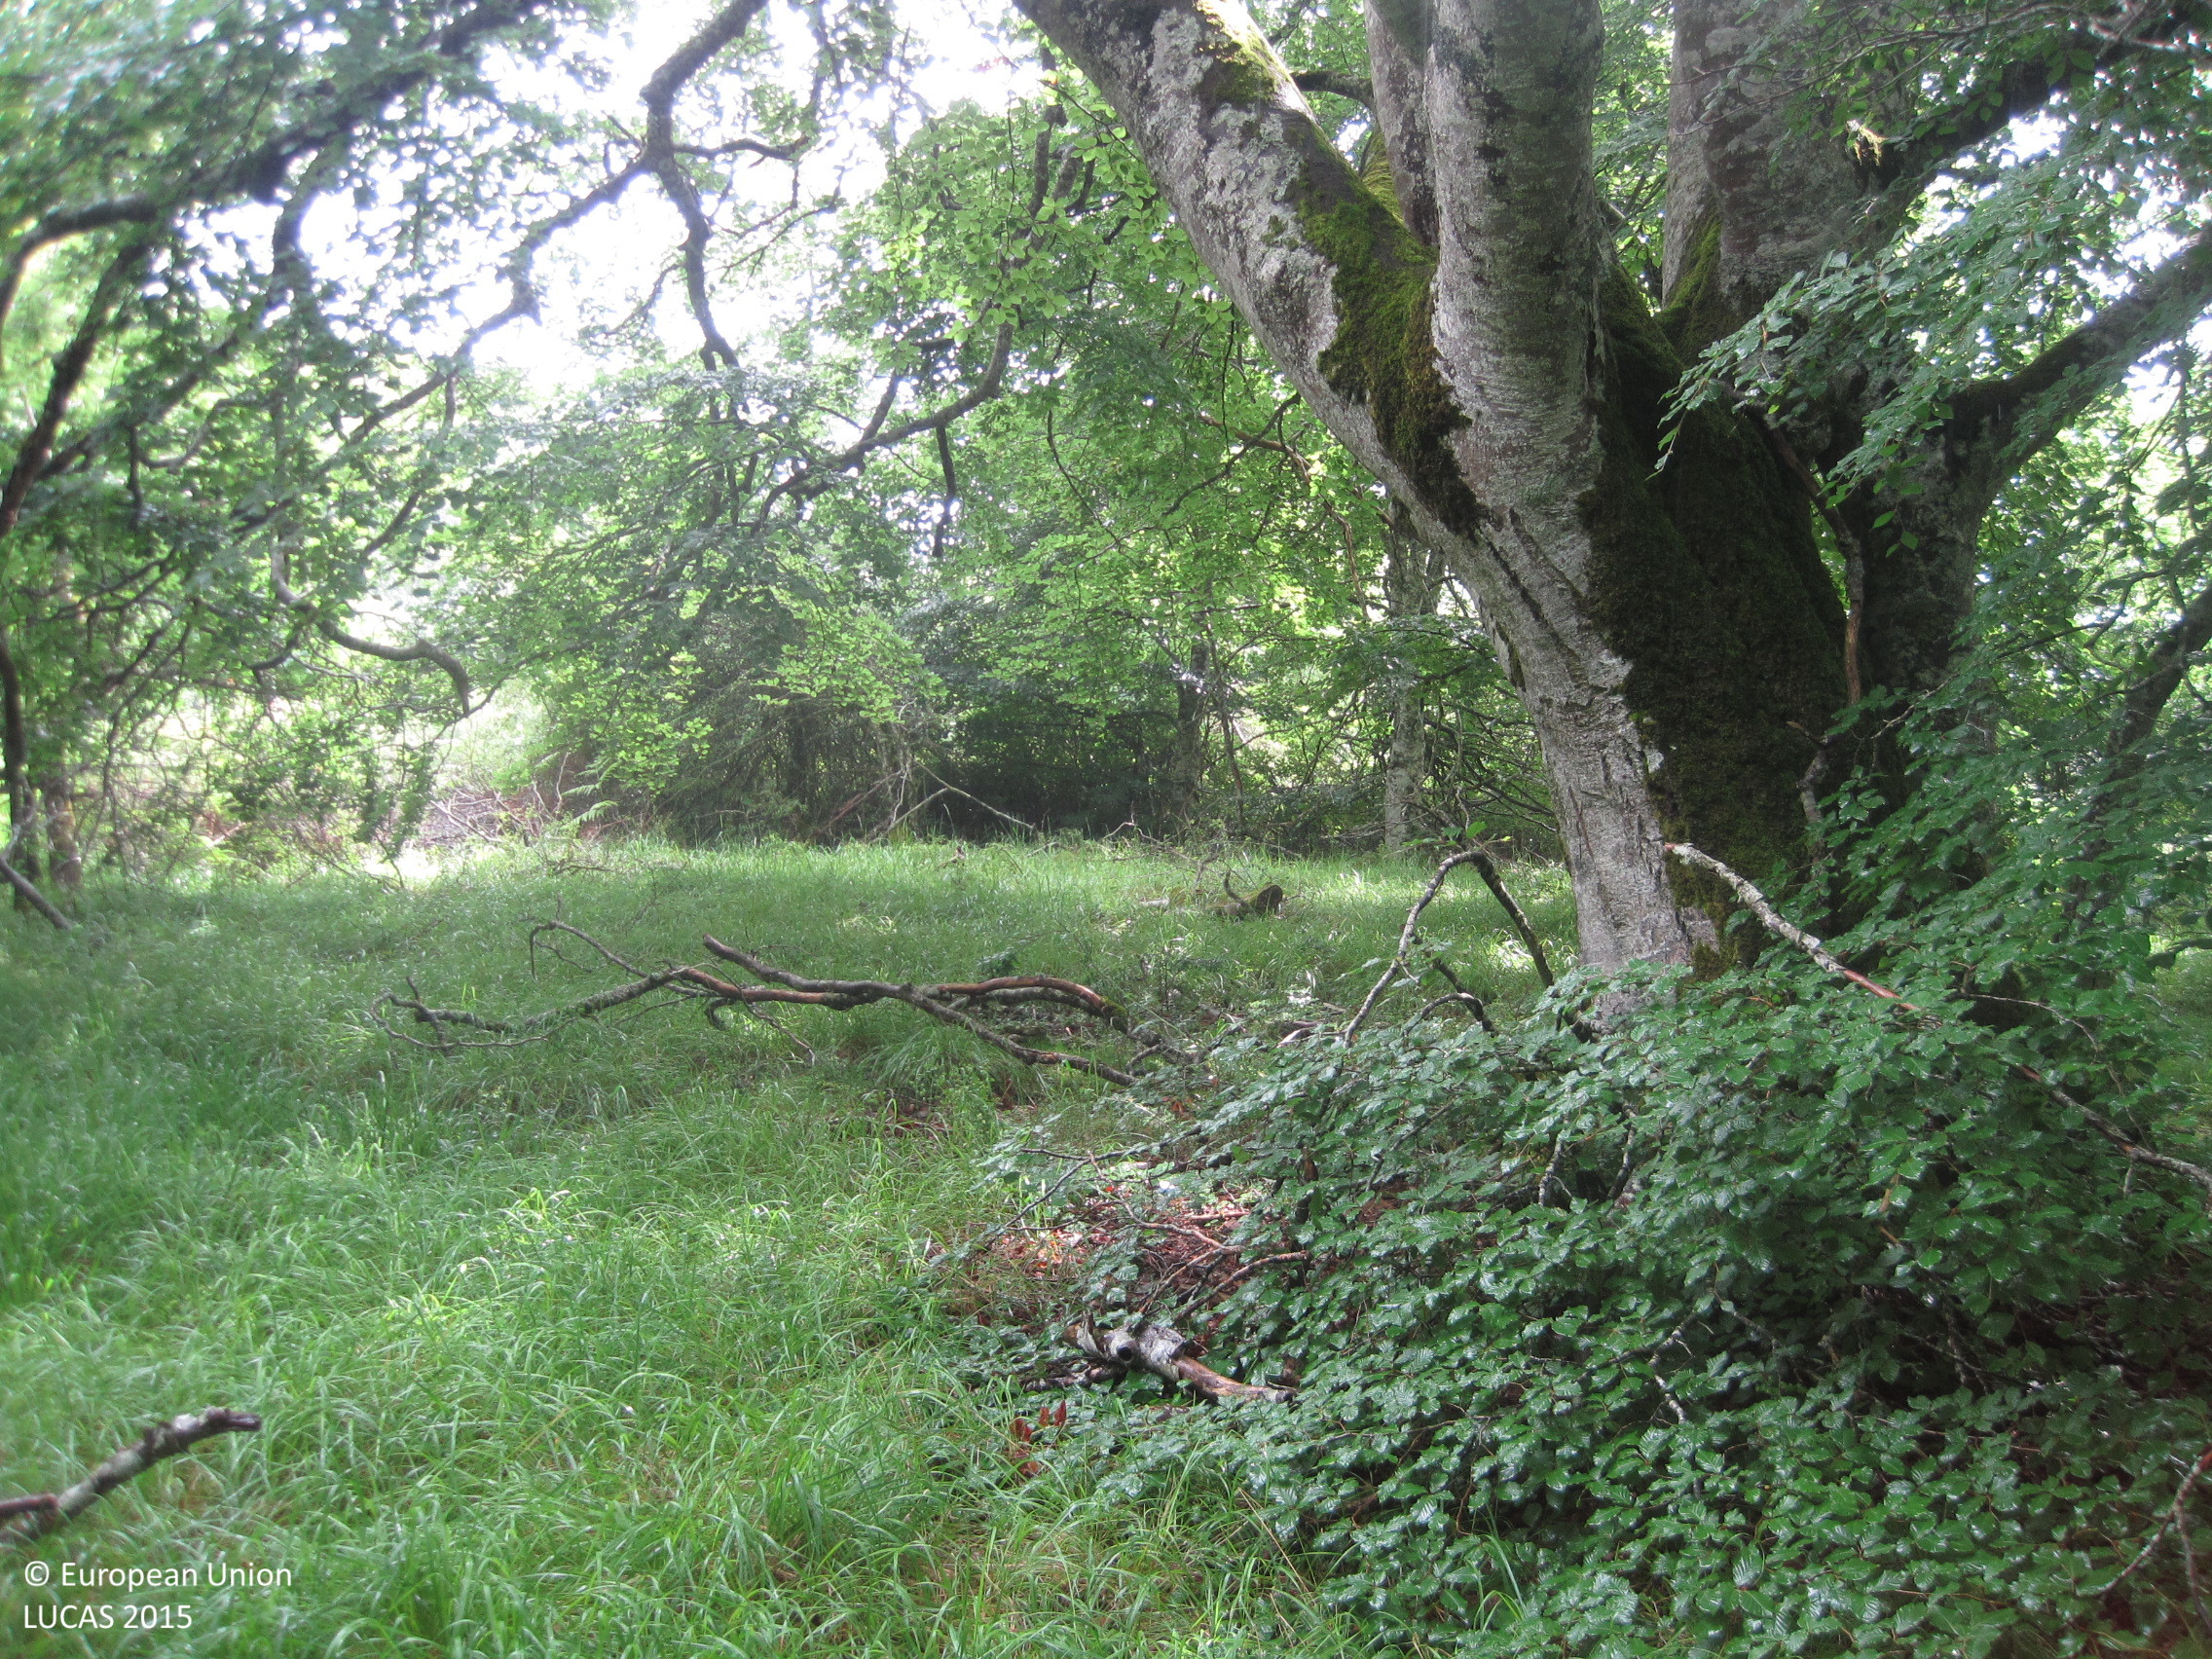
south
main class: Woodland
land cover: Broadleaved woodland
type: beech forest
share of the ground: > 75 %
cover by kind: broadleaved forest trees 95 %, herbaceous plants 5 %
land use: Forestry
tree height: > 5 m
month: June
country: ES
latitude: 42.7881
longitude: -2.2087
